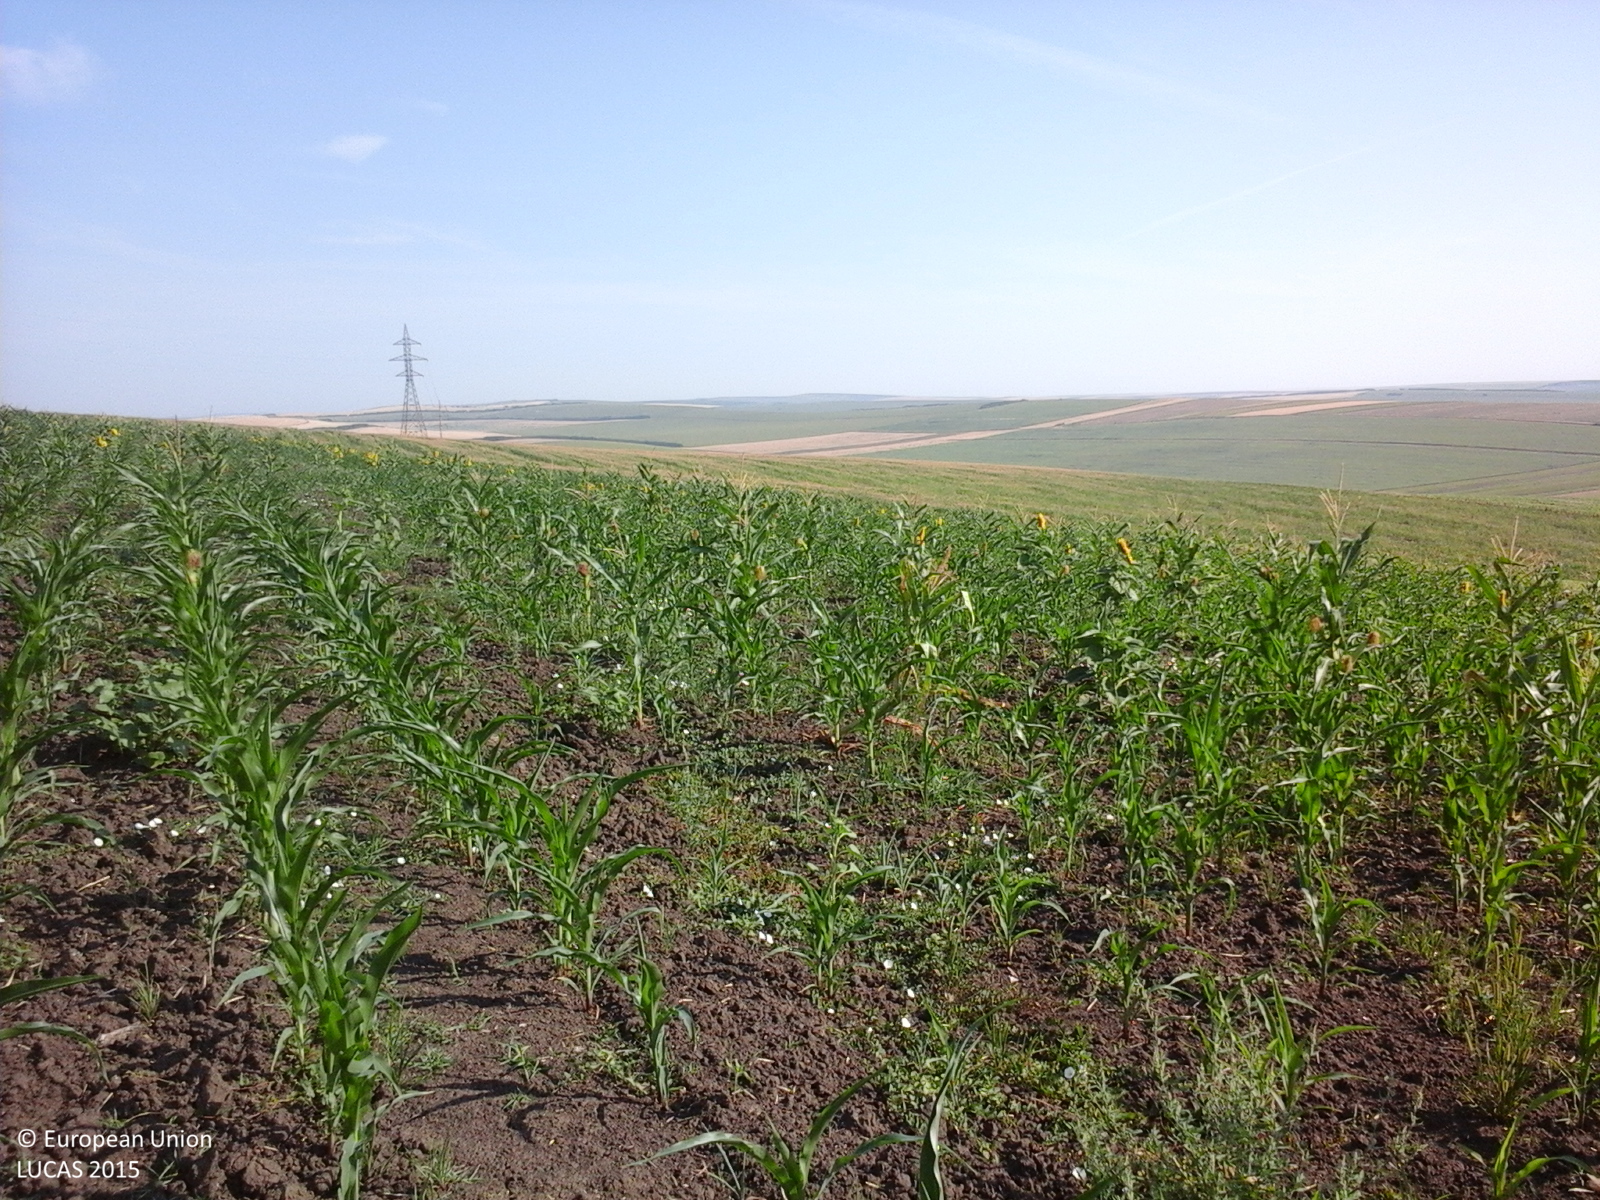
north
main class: Cropland
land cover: Maize
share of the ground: 50 - 75 %
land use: Agriculture (excluding fallow land and kitchen gardens)
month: July
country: RO
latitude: 46.2747
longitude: 28.0470
